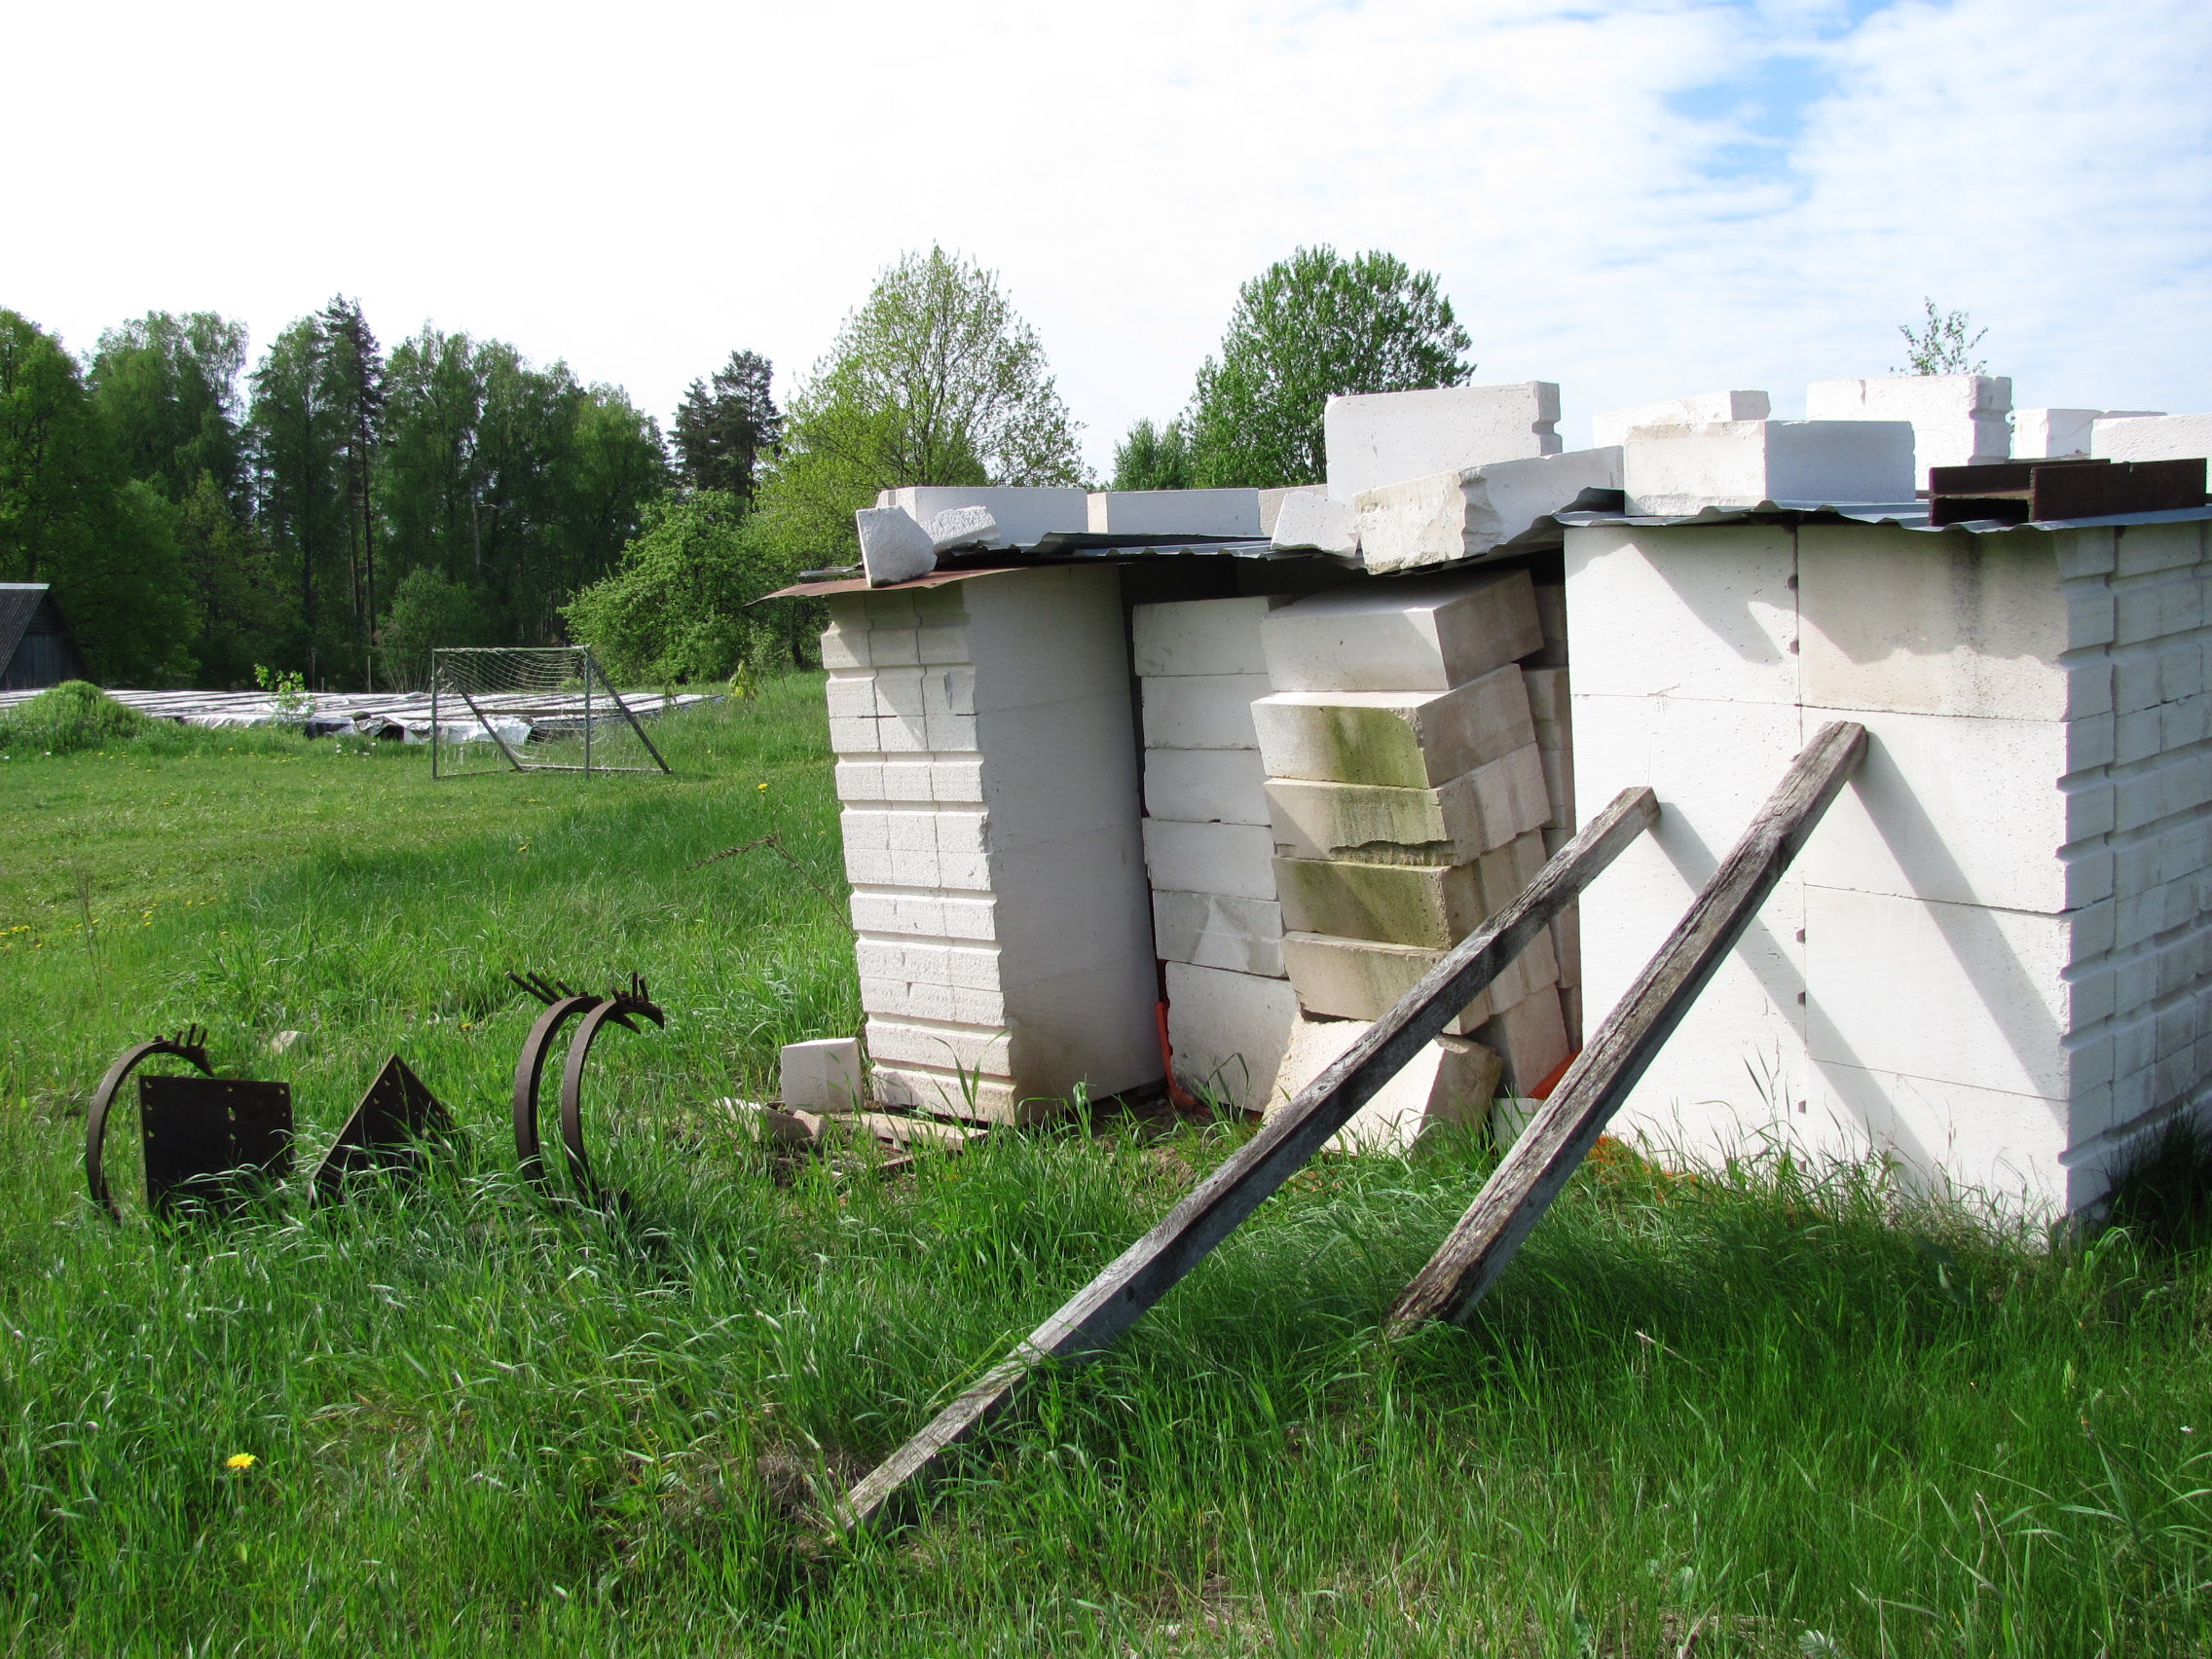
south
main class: Grassland
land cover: Grassland without tree/shrub cover
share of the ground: > 75 %
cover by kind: herbaceous plants 100 %
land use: Agriculture (excluding fallow land and kitchen gardens)
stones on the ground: < 10 %
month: May
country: LV
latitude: 56.8022
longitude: 24.3547
